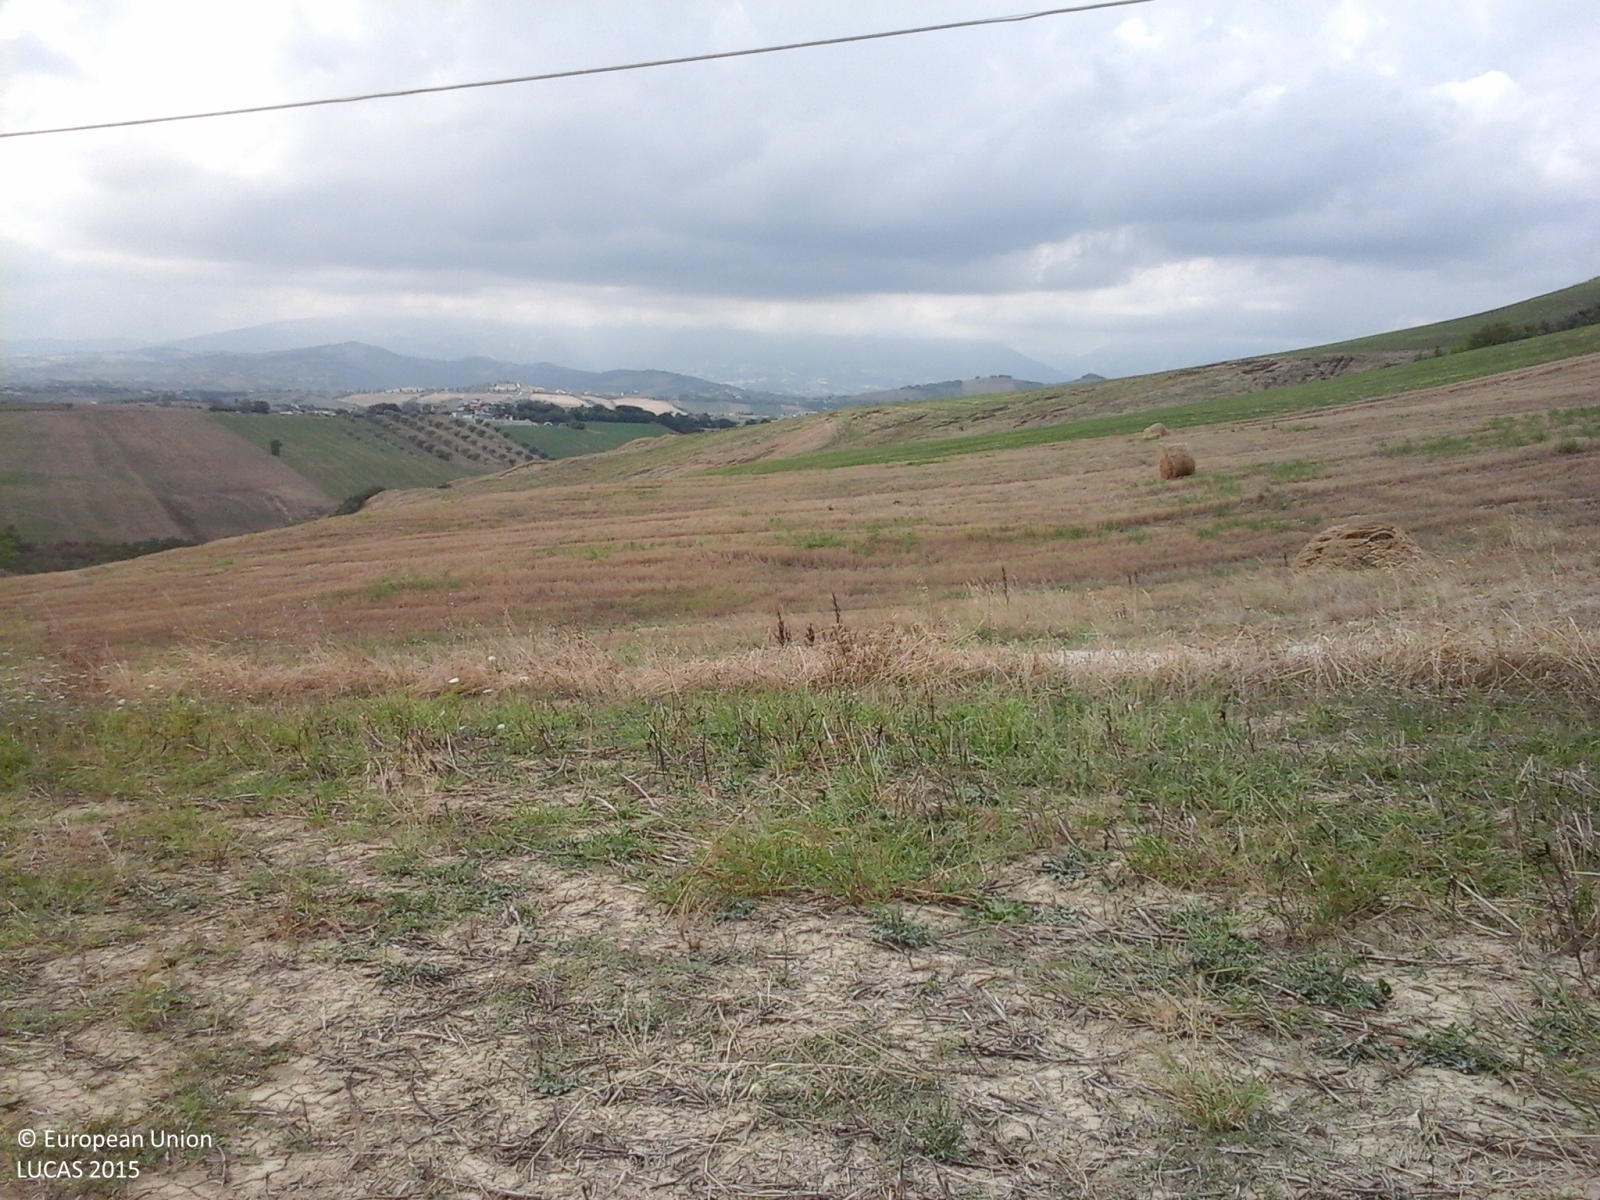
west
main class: Cropland
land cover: Dry pulses
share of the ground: < 10 %
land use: Agriculture (excluding fallow land and kitchen gardens)
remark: Harvested field
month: August
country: IT
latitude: 42.7269
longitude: 13.8117
